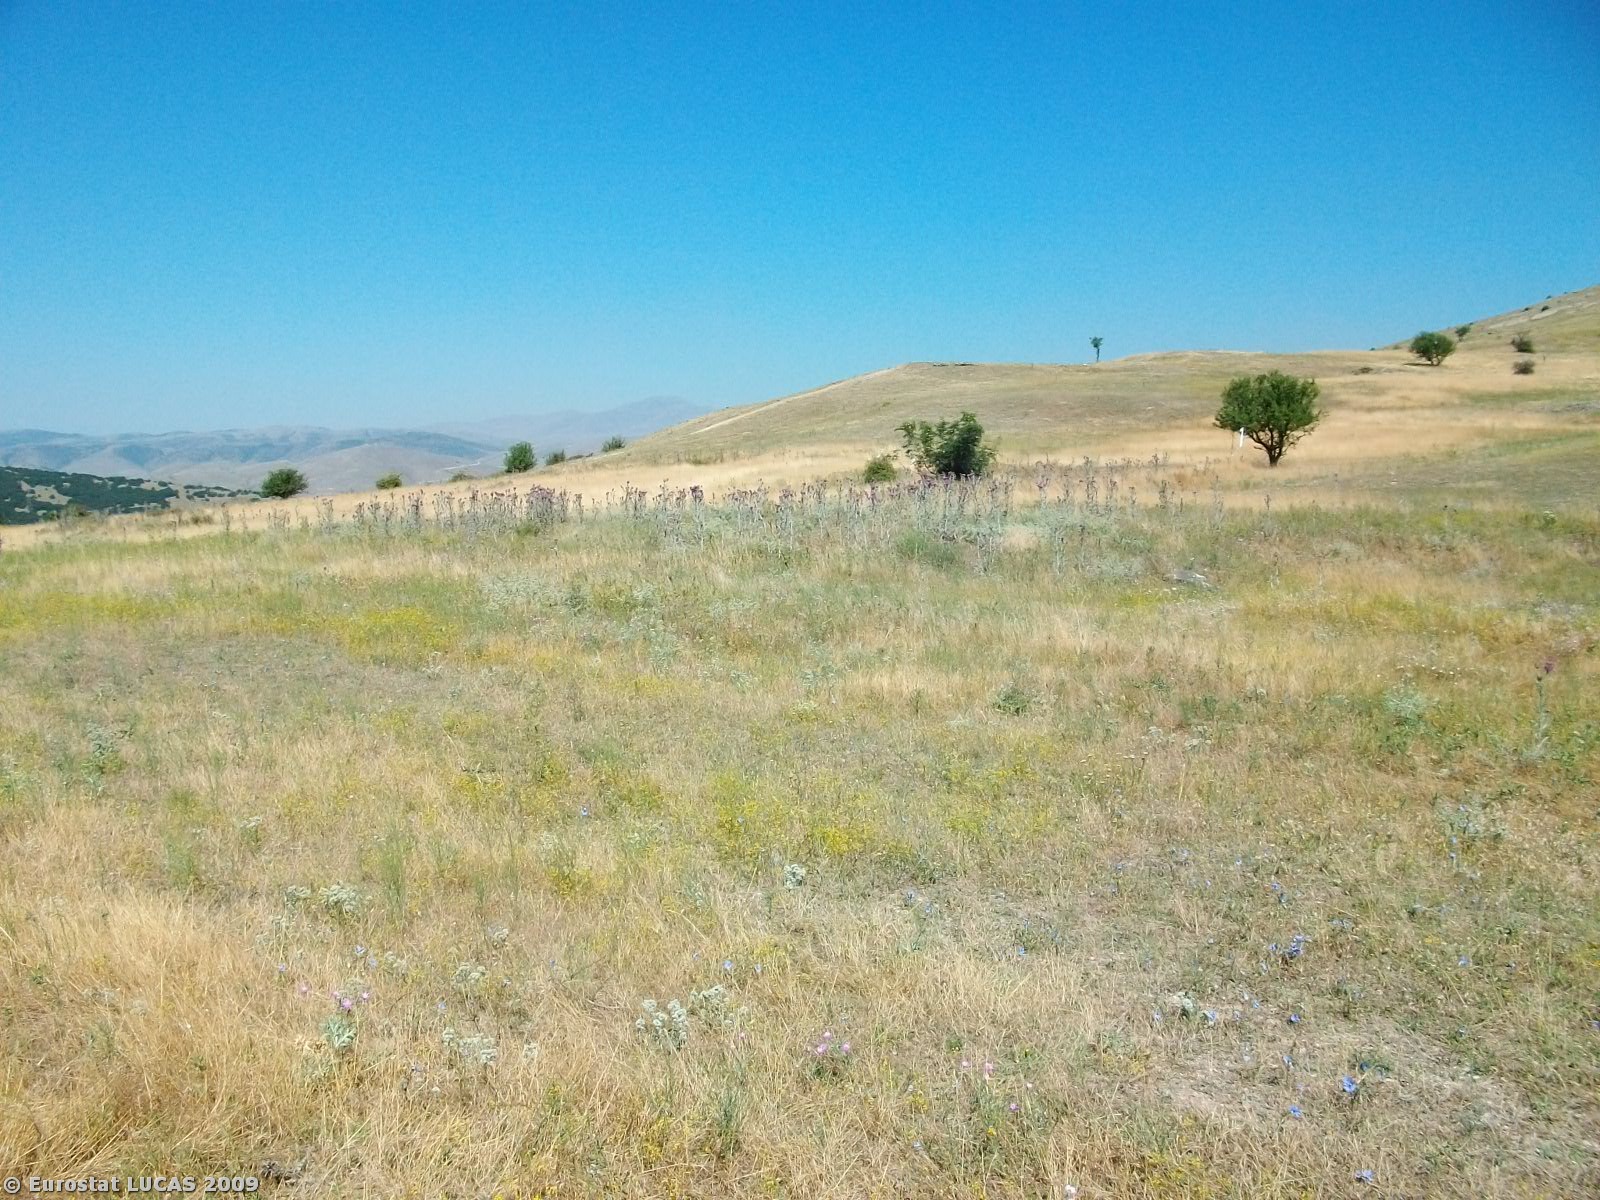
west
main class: Artificial land
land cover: Non built-up linear features
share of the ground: > 75 %
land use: Road transport
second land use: Agriculture (excluding fallow land and kitchen gardens)
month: July
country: GR
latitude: 40.3324
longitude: 21.8456
